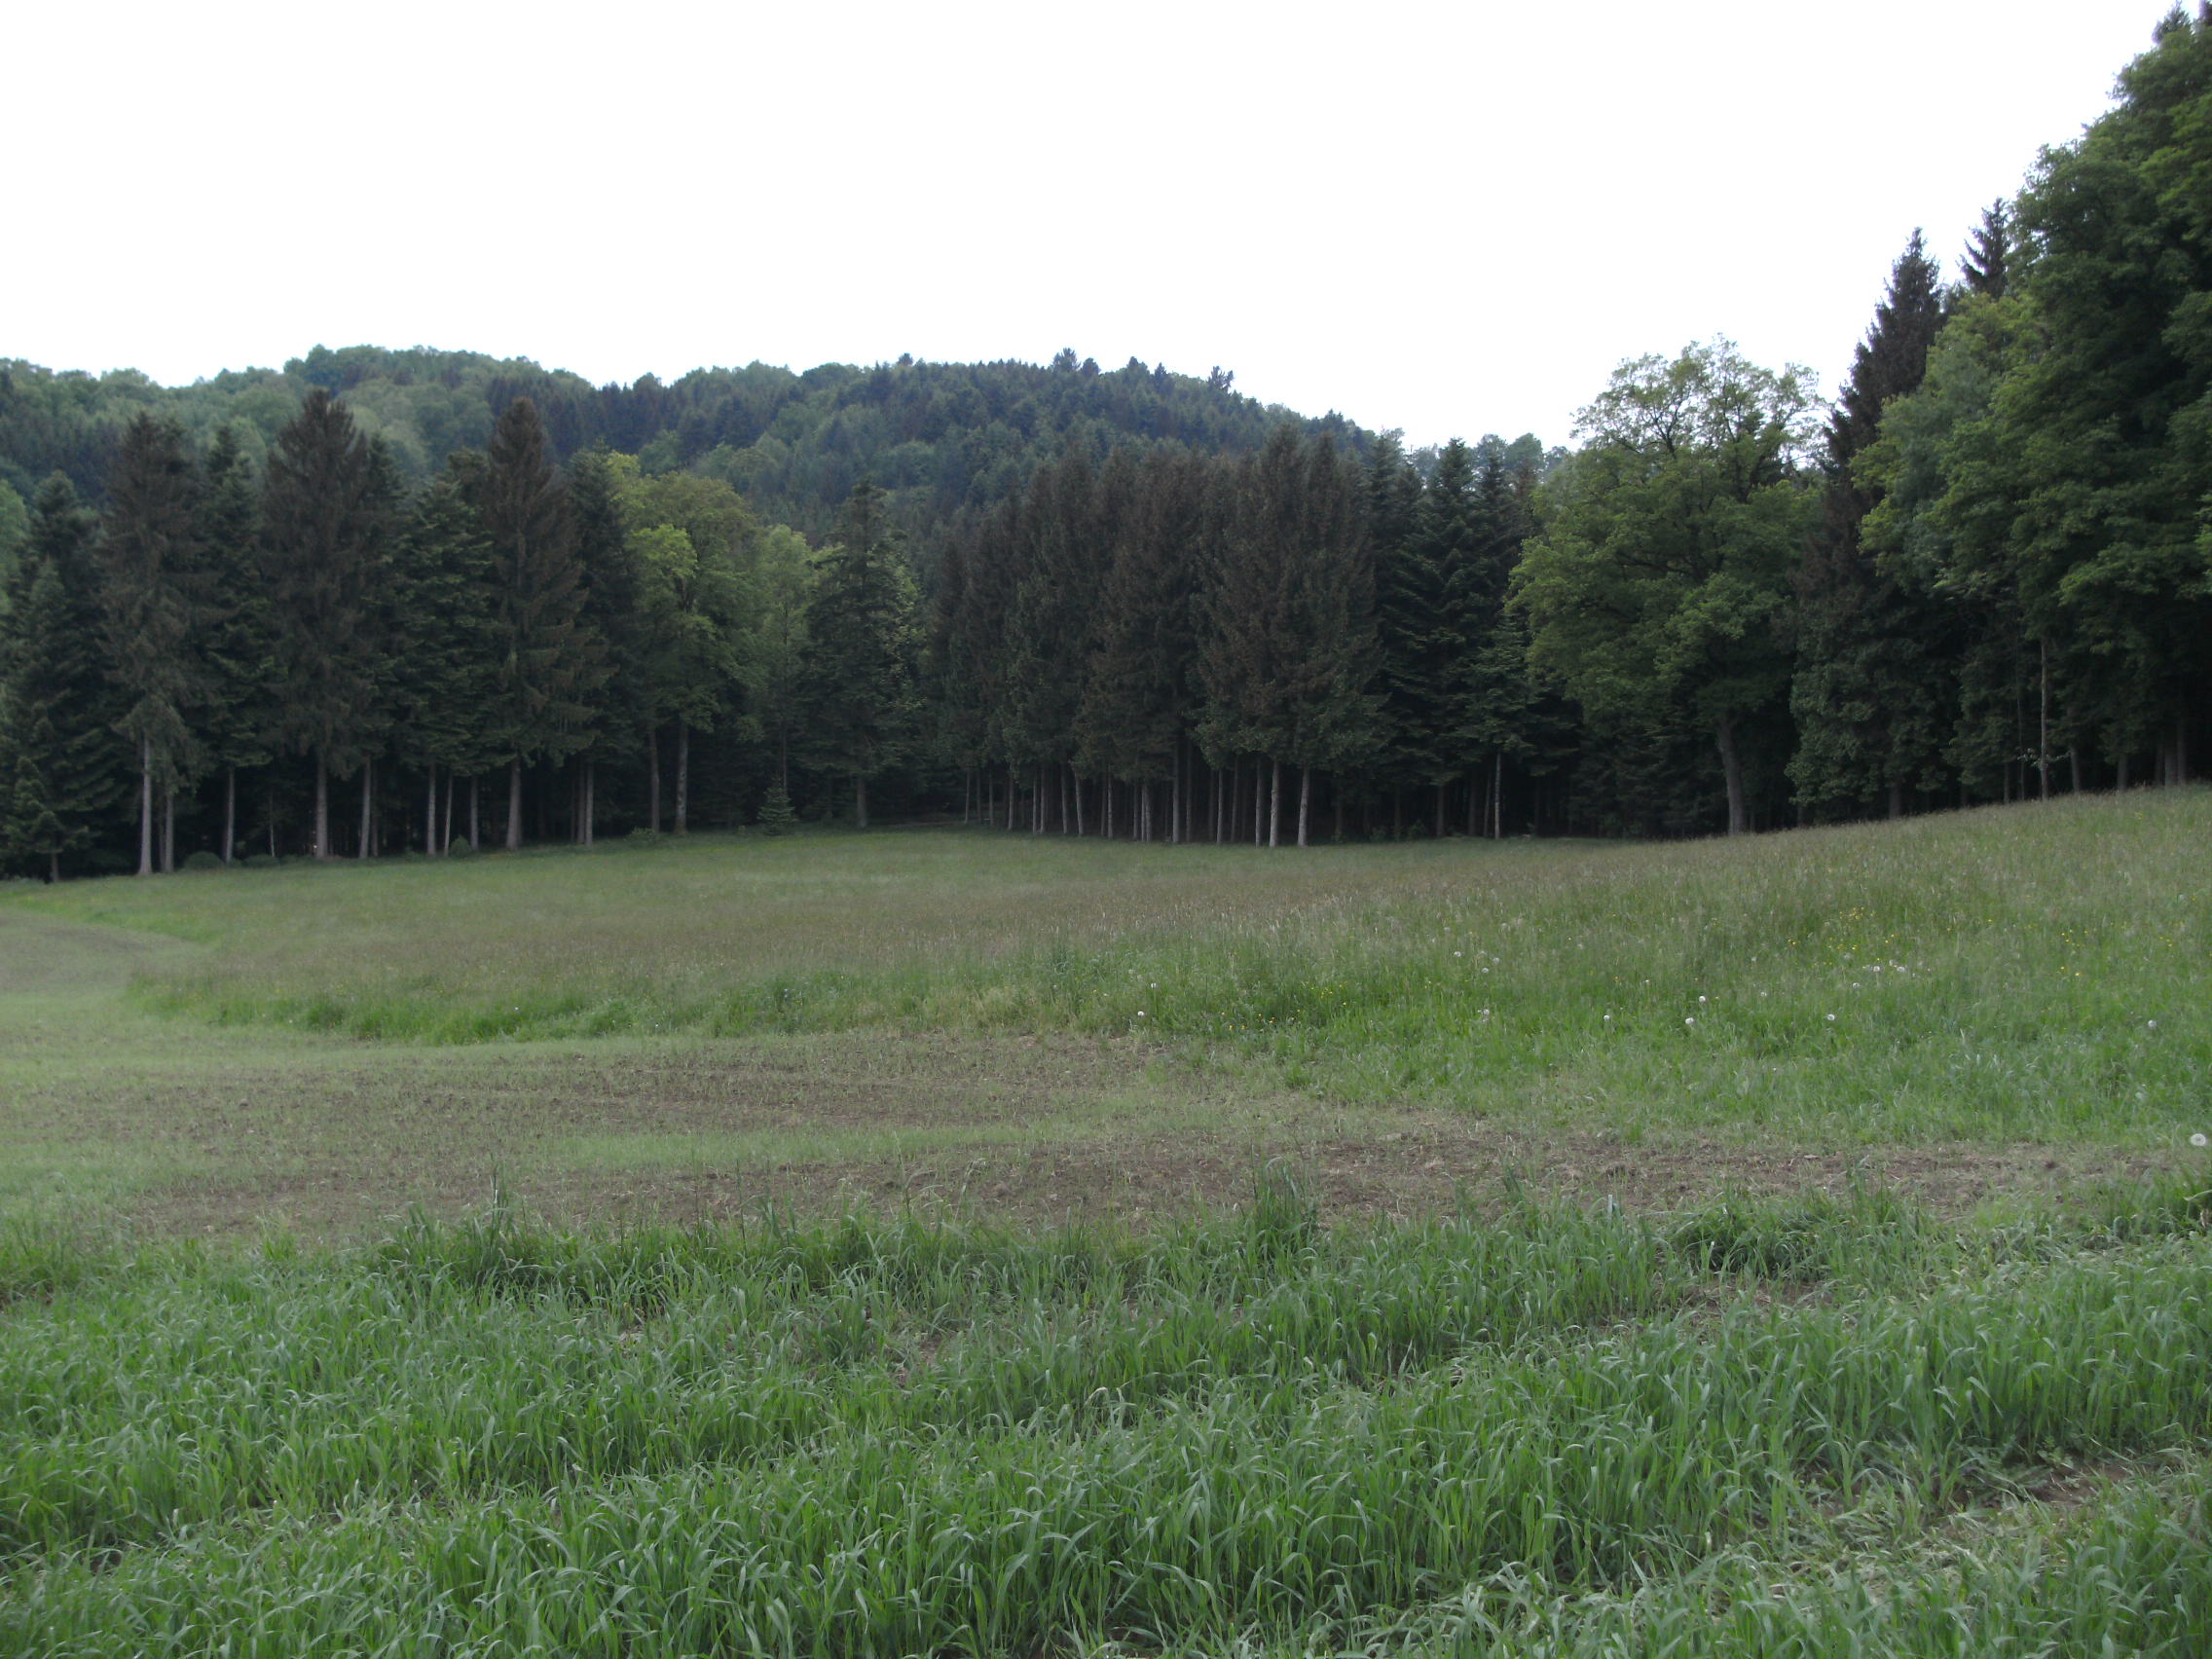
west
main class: Cropland
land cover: Rye
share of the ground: > 75 %
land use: Agriculture (excluding fallow land and kitchen gardens)
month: May
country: AT
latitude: 48.3906
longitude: 13.8486
